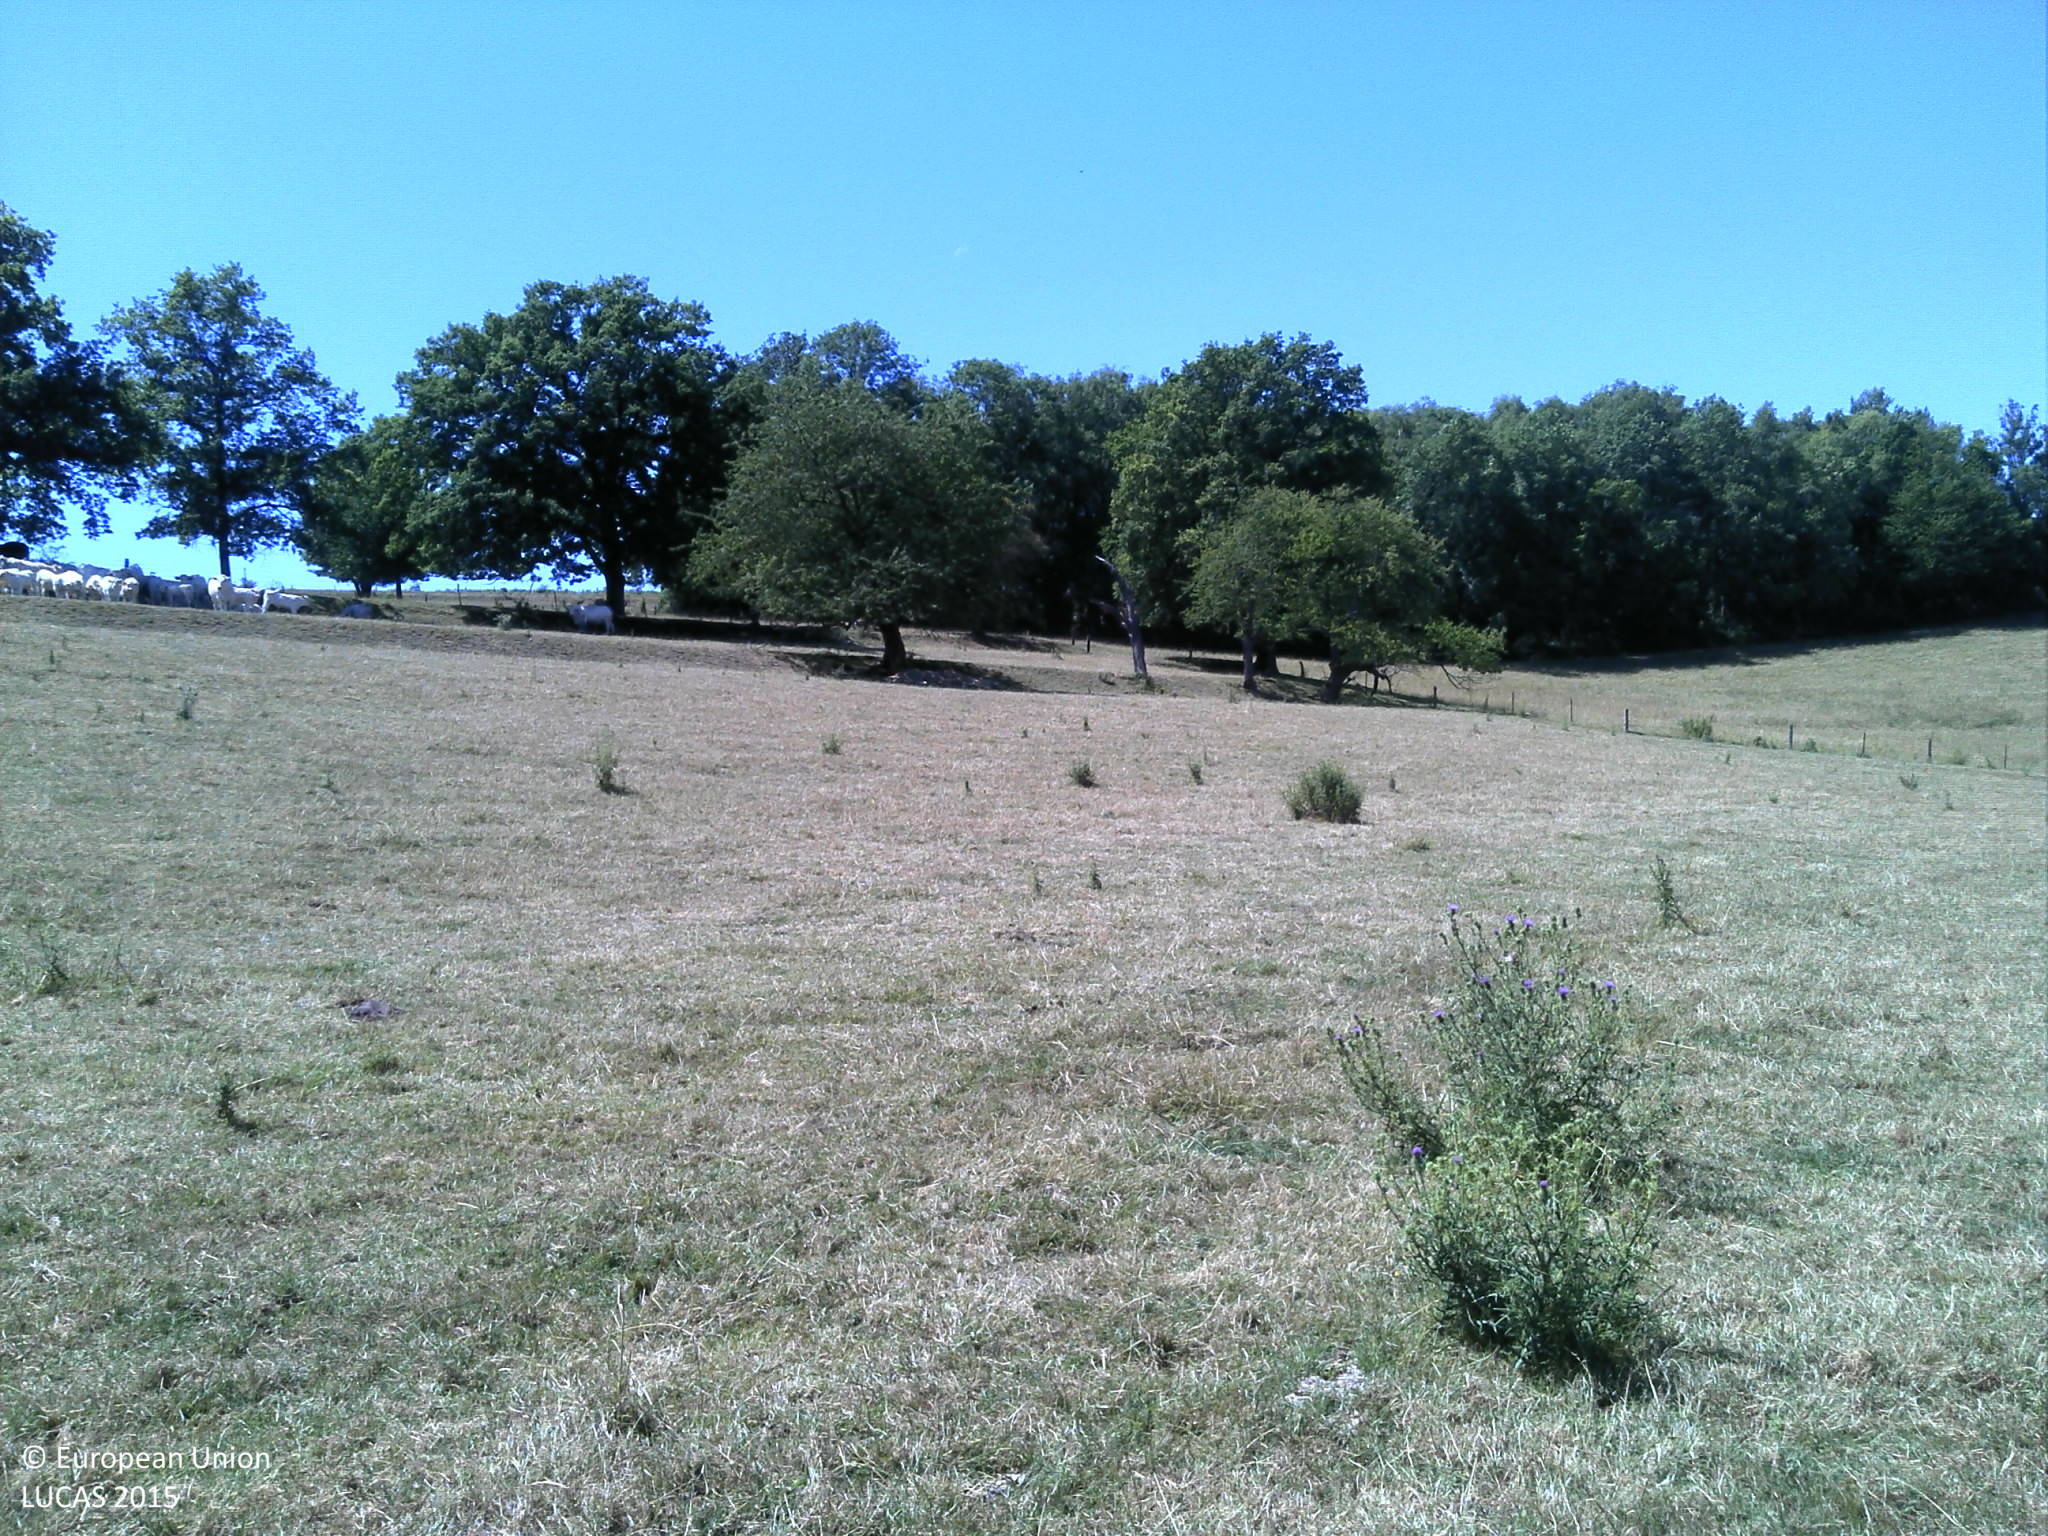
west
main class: Grassland
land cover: Grassland with sparse tree/shrub cover
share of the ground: > 75 %
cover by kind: herbaceous plants 95 %, broadleaved forest trees 5 %
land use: Agriculture (excluding fallow land and kitchen gardens)
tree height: > 5 m
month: July
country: FR
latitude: 49.5578
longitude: 4.7298
